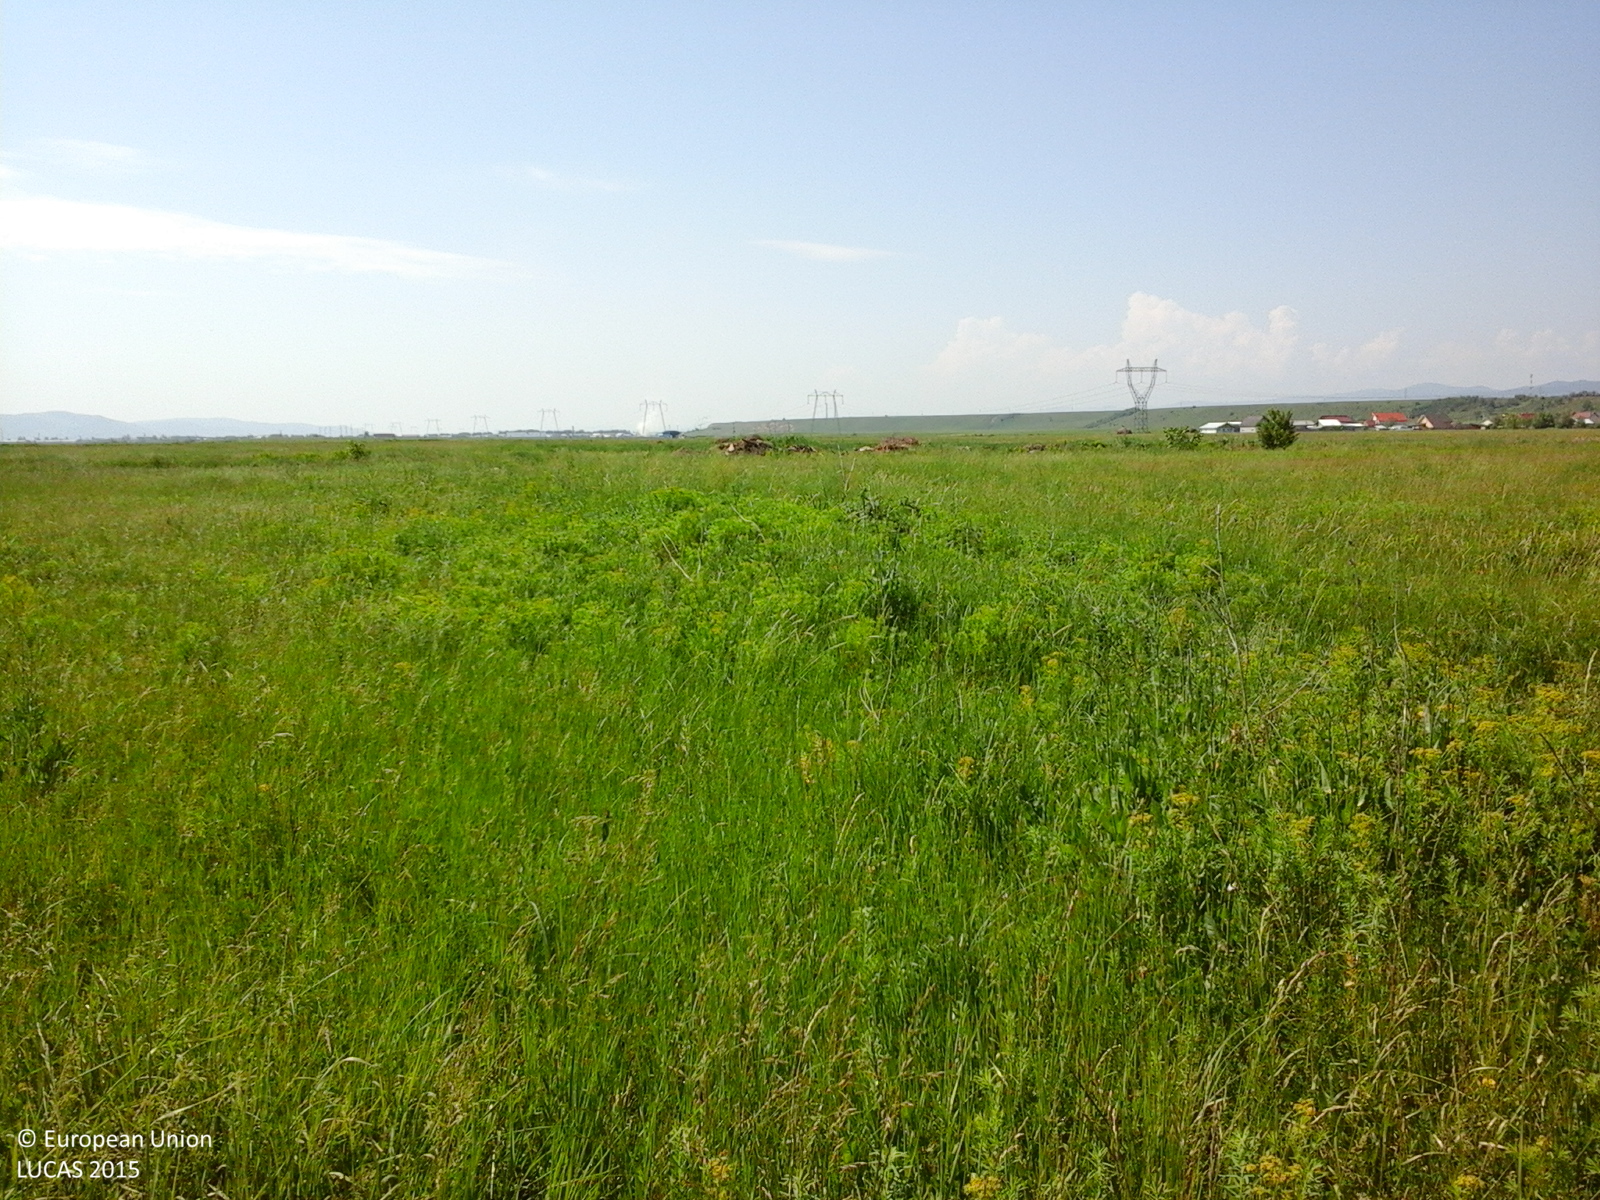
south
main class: Grassland
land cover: Grassland without tree/shrub cover
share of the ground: > 75 %
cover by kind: herbaceous plants 100 %
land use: Agriculture (excluding fallow land and kitchen gardens)
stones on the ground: < 10 %
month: June
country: RO
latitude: 46.6215
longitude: 26.9551
